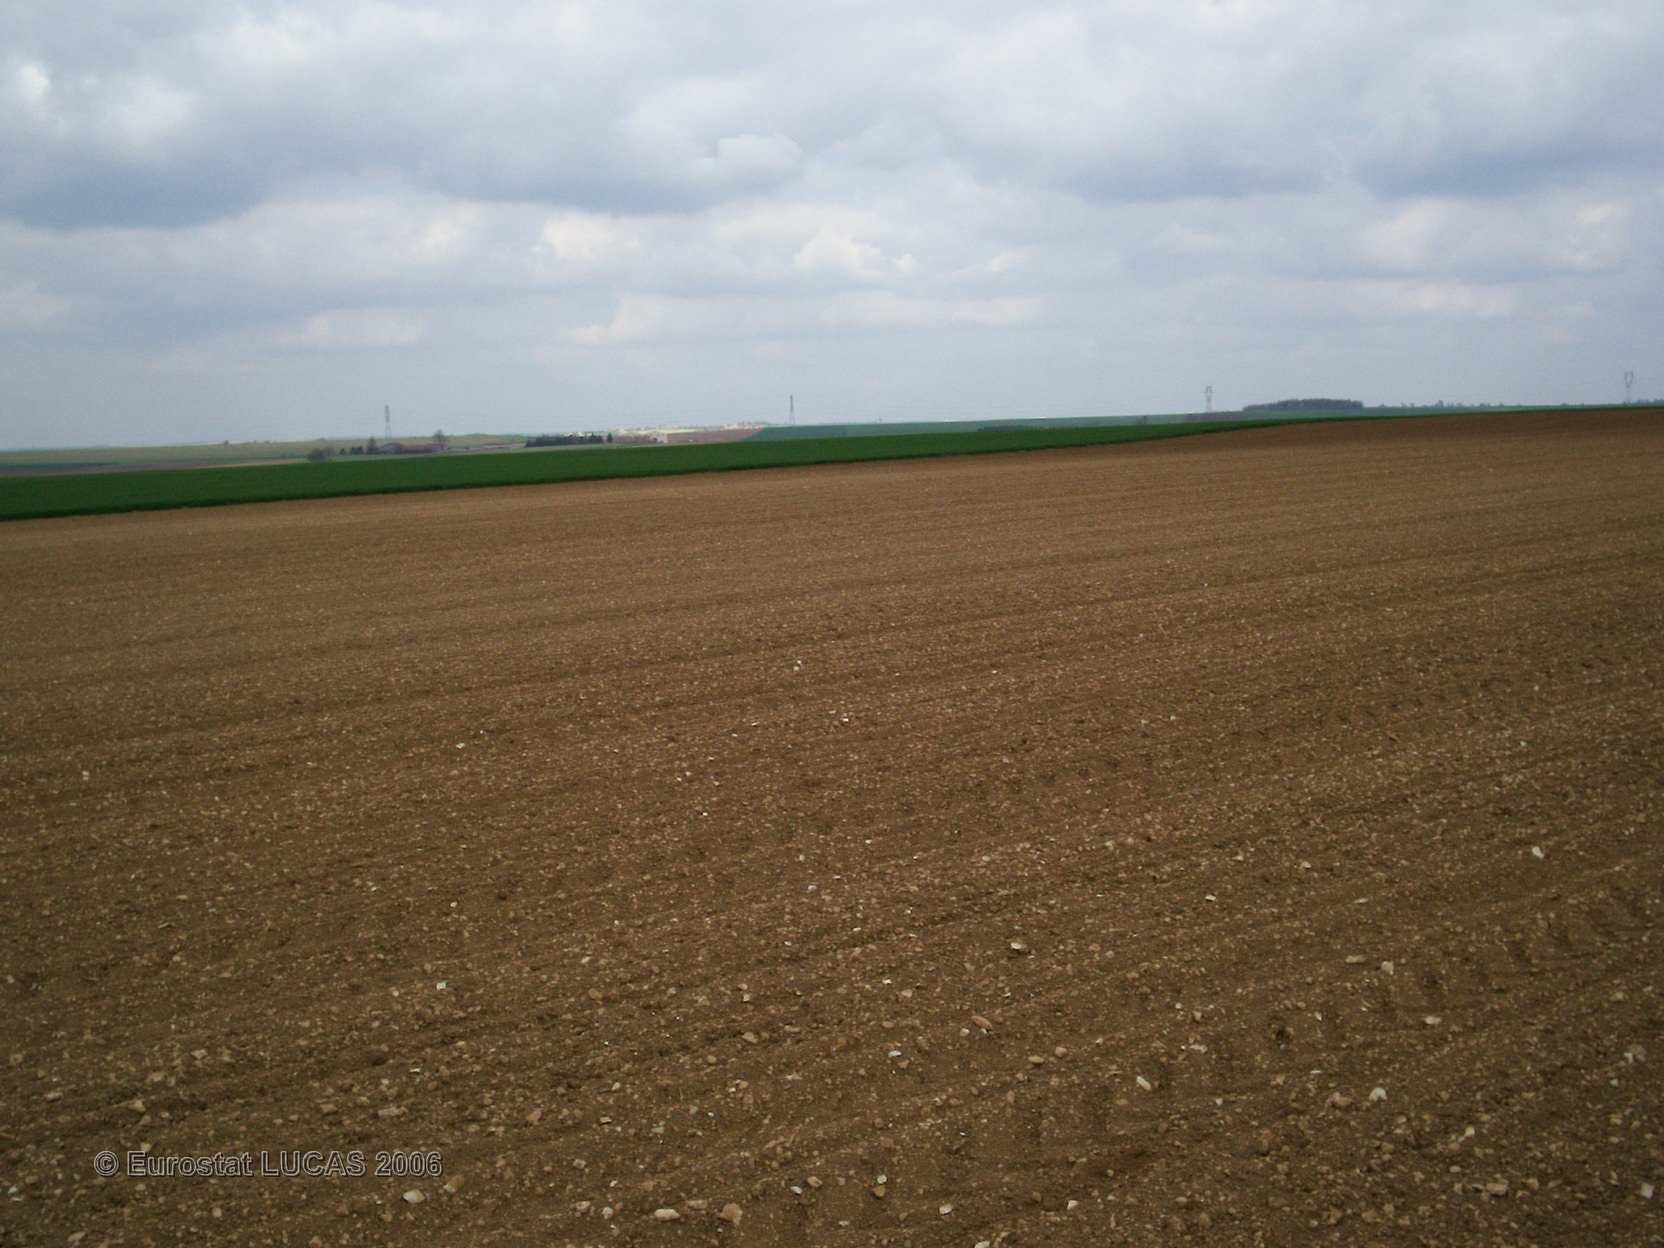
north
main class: Cropland
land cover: Sugar beet
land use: Agriculture (excluding fallow land and kitchen gardens)
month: April
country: FR
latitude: 48.5019
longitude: 4.5159
